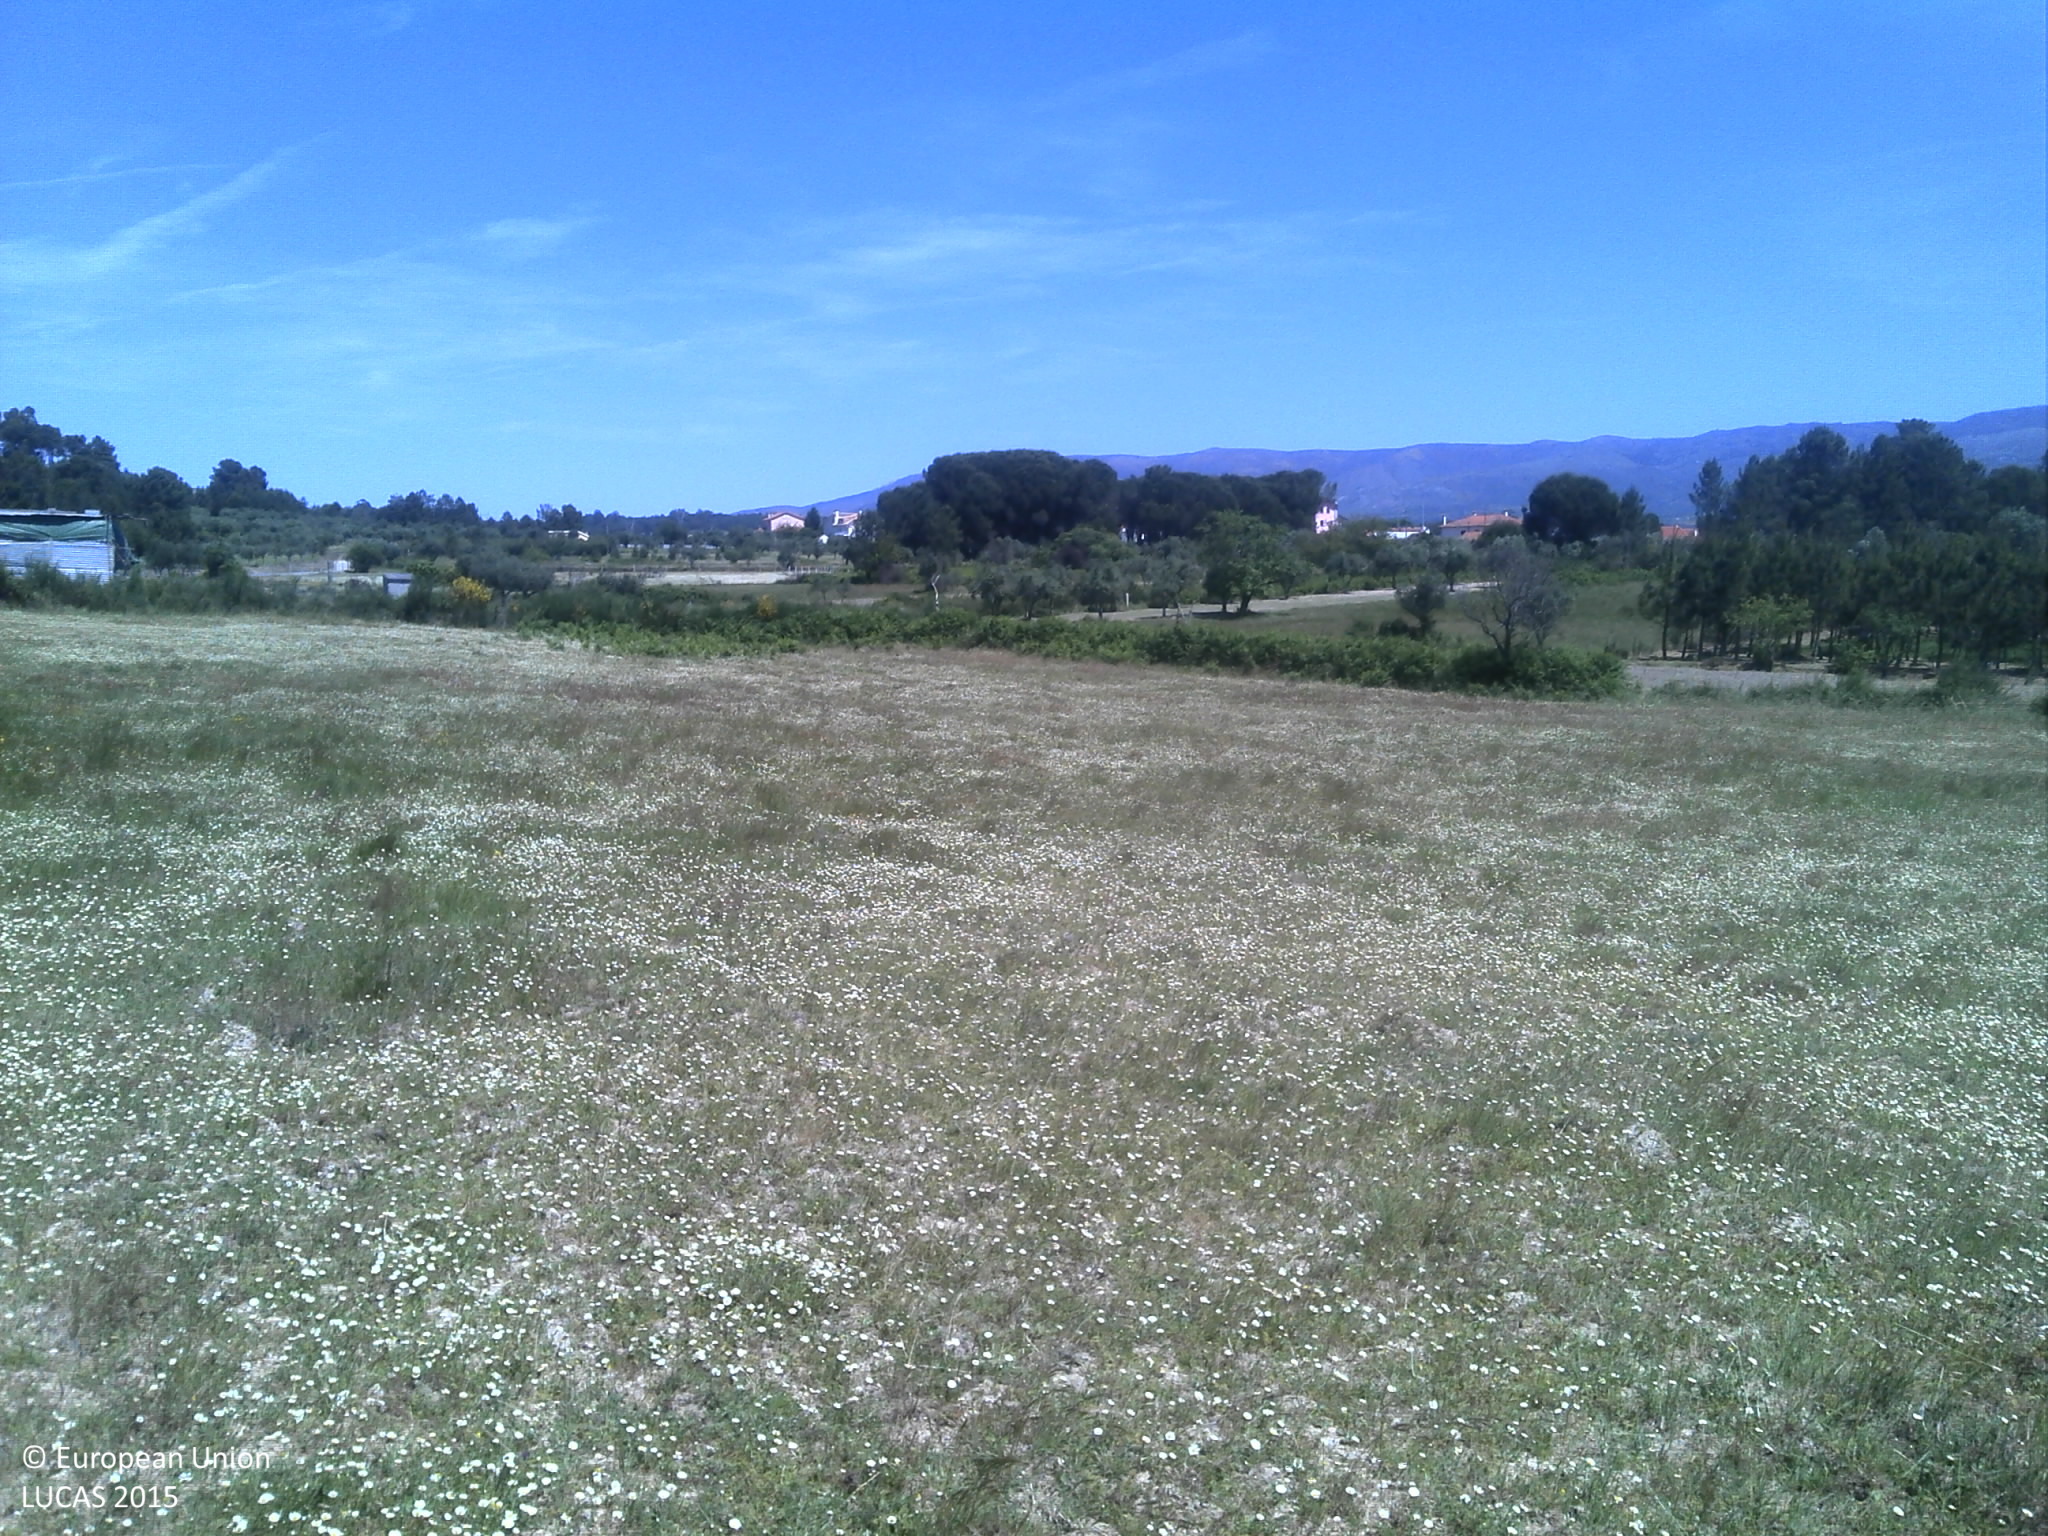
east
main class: Grassland
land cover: Grassland without tree/shrub cover
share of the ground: 25 - 50 %
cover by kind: herbaceous plants 50 %, unconsolidated bare surface 50 %
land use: Agriculture (excluding fallow land and kitchen gardens)
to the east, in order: Grassland without tree/shrub cover; Fences; Shruby margins; Grassland without tree/shrub cover; Olive groves; Grassland without tree/shrub cover; Fences; Rivers and streams; Grassland without tree/shrub cover; Dry stone walls; Shrubland without tree cover
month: May
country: PT
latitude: 40.4845
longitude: -7.7296
